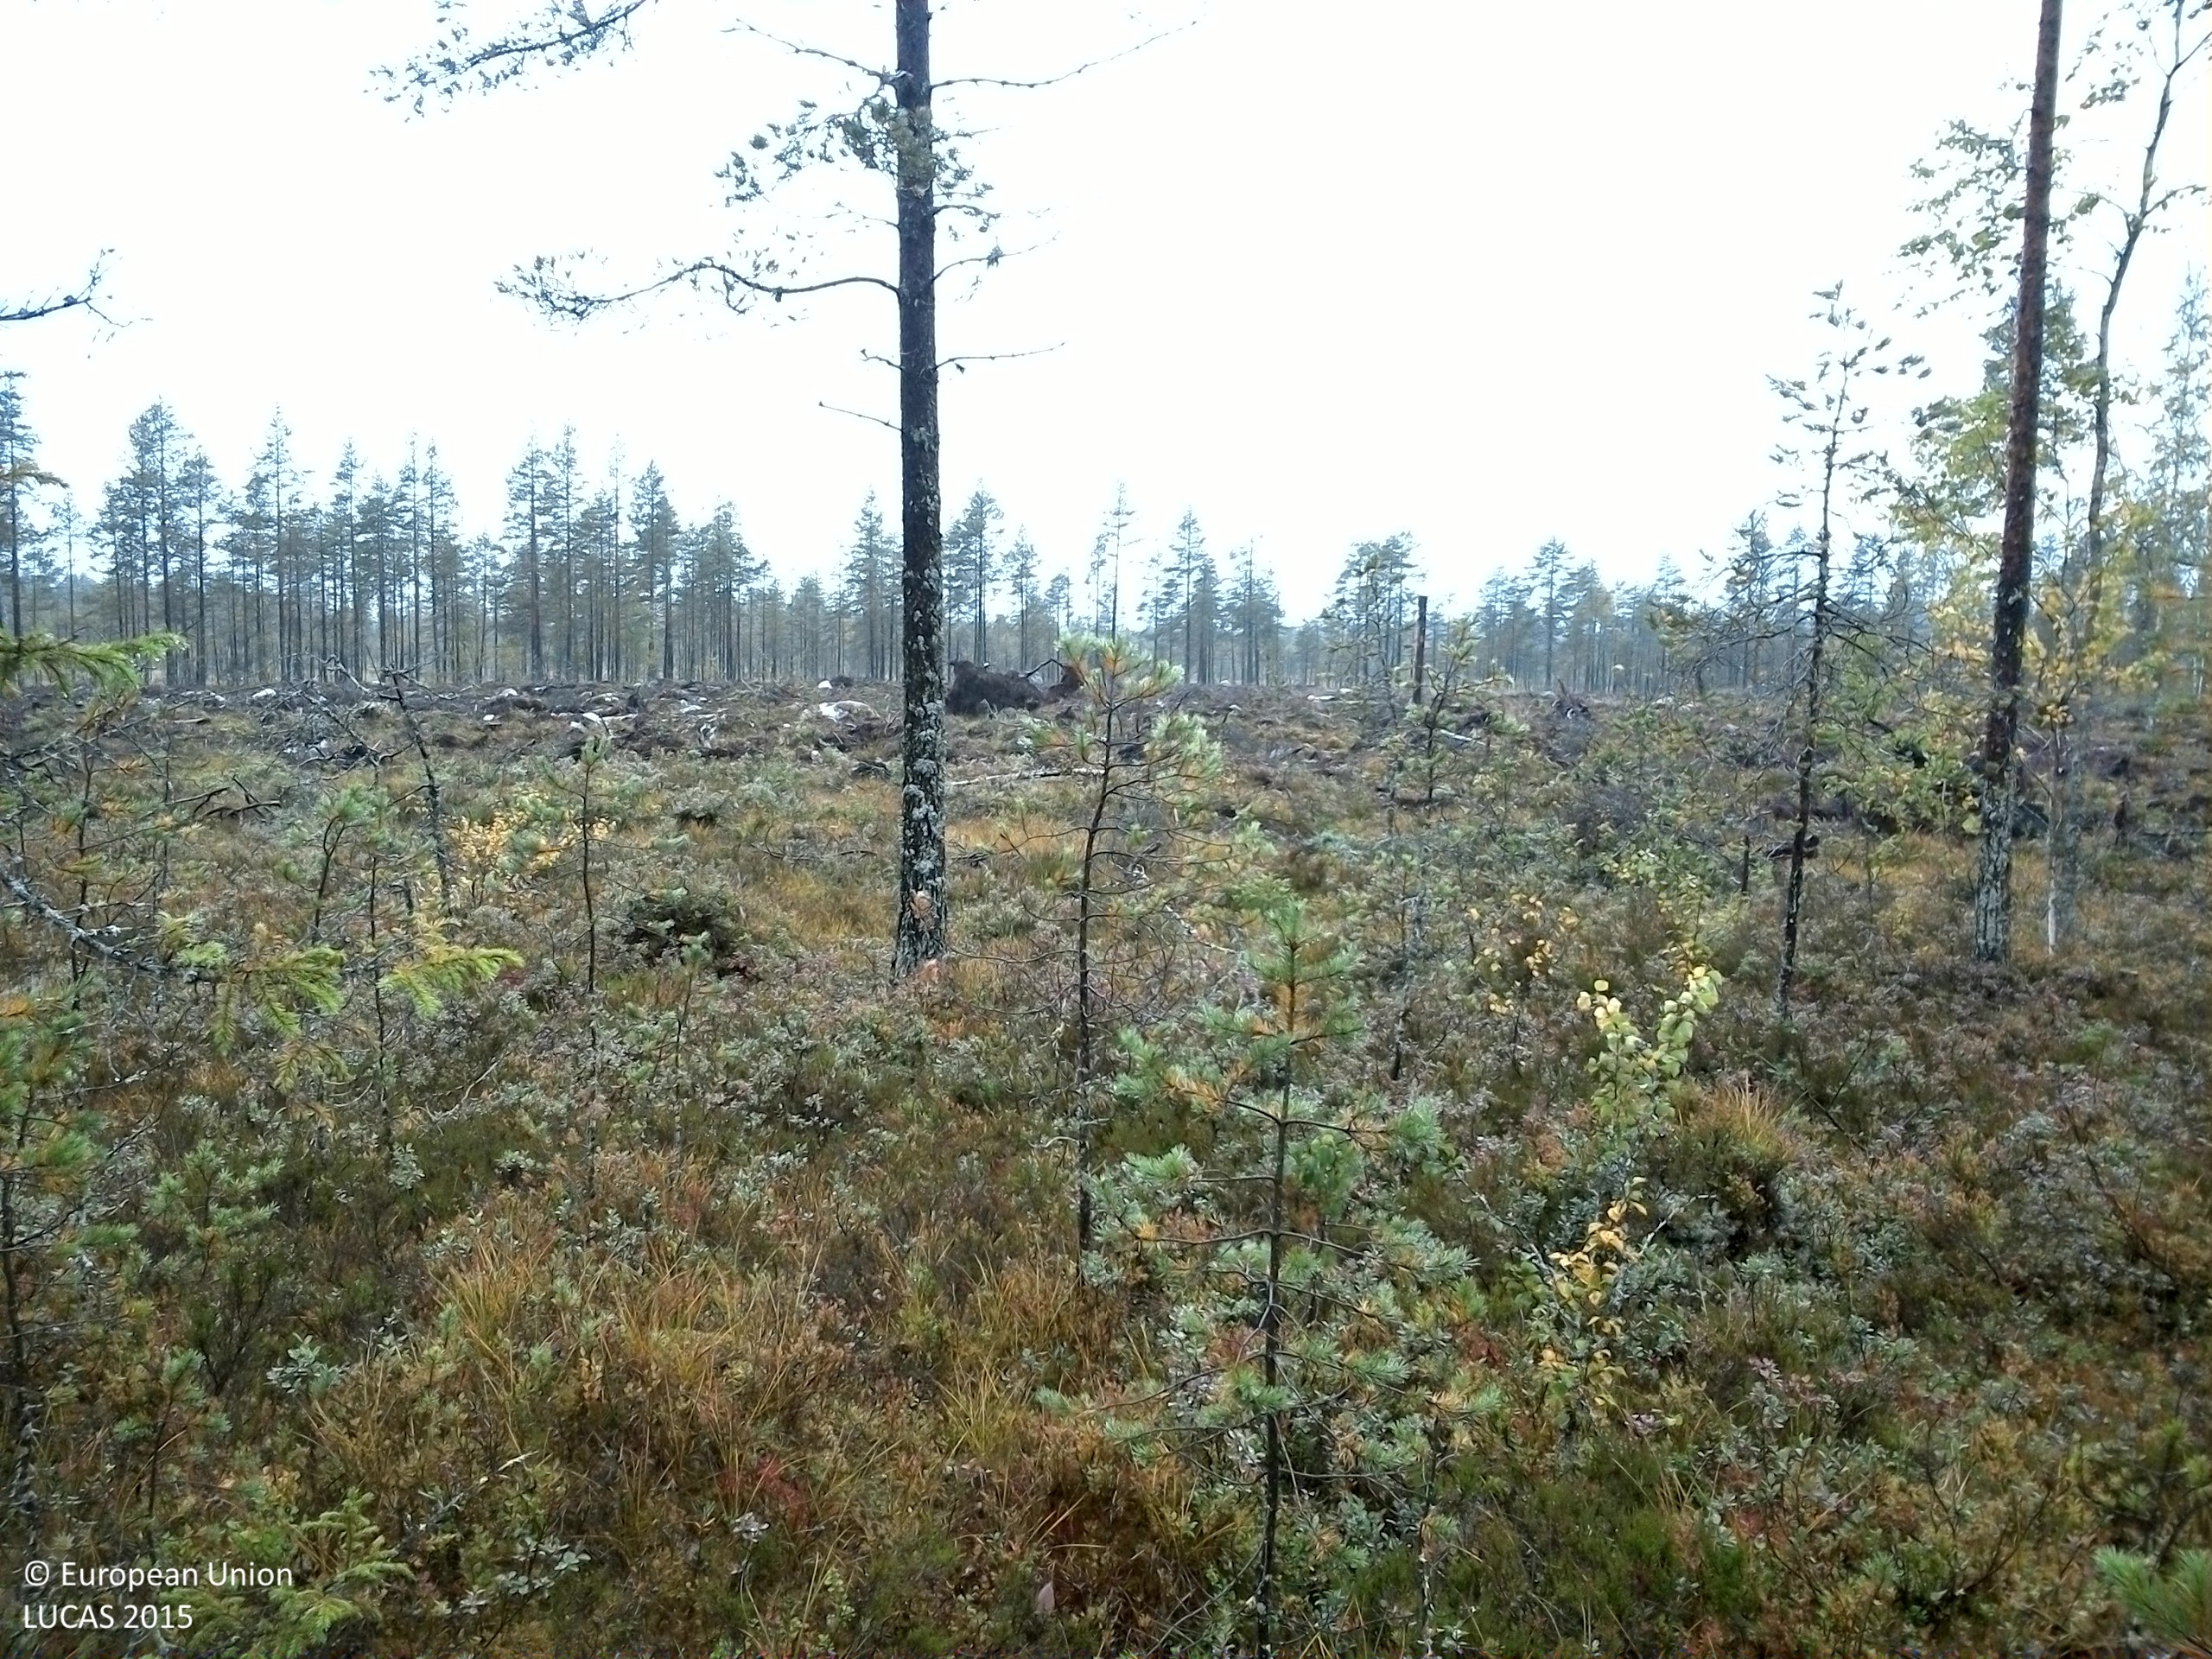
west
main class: Woodland
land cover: Pine dominated coniferous woodland
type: boreal forest
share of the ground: 25 - 50 %
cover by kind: coniferous forest trees 50 %, shrubs 30 %, lichens and mosses 20 %
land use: Forestry
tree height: > 5 m
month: September
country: SE
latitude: 61.4793
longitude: 15.0722
